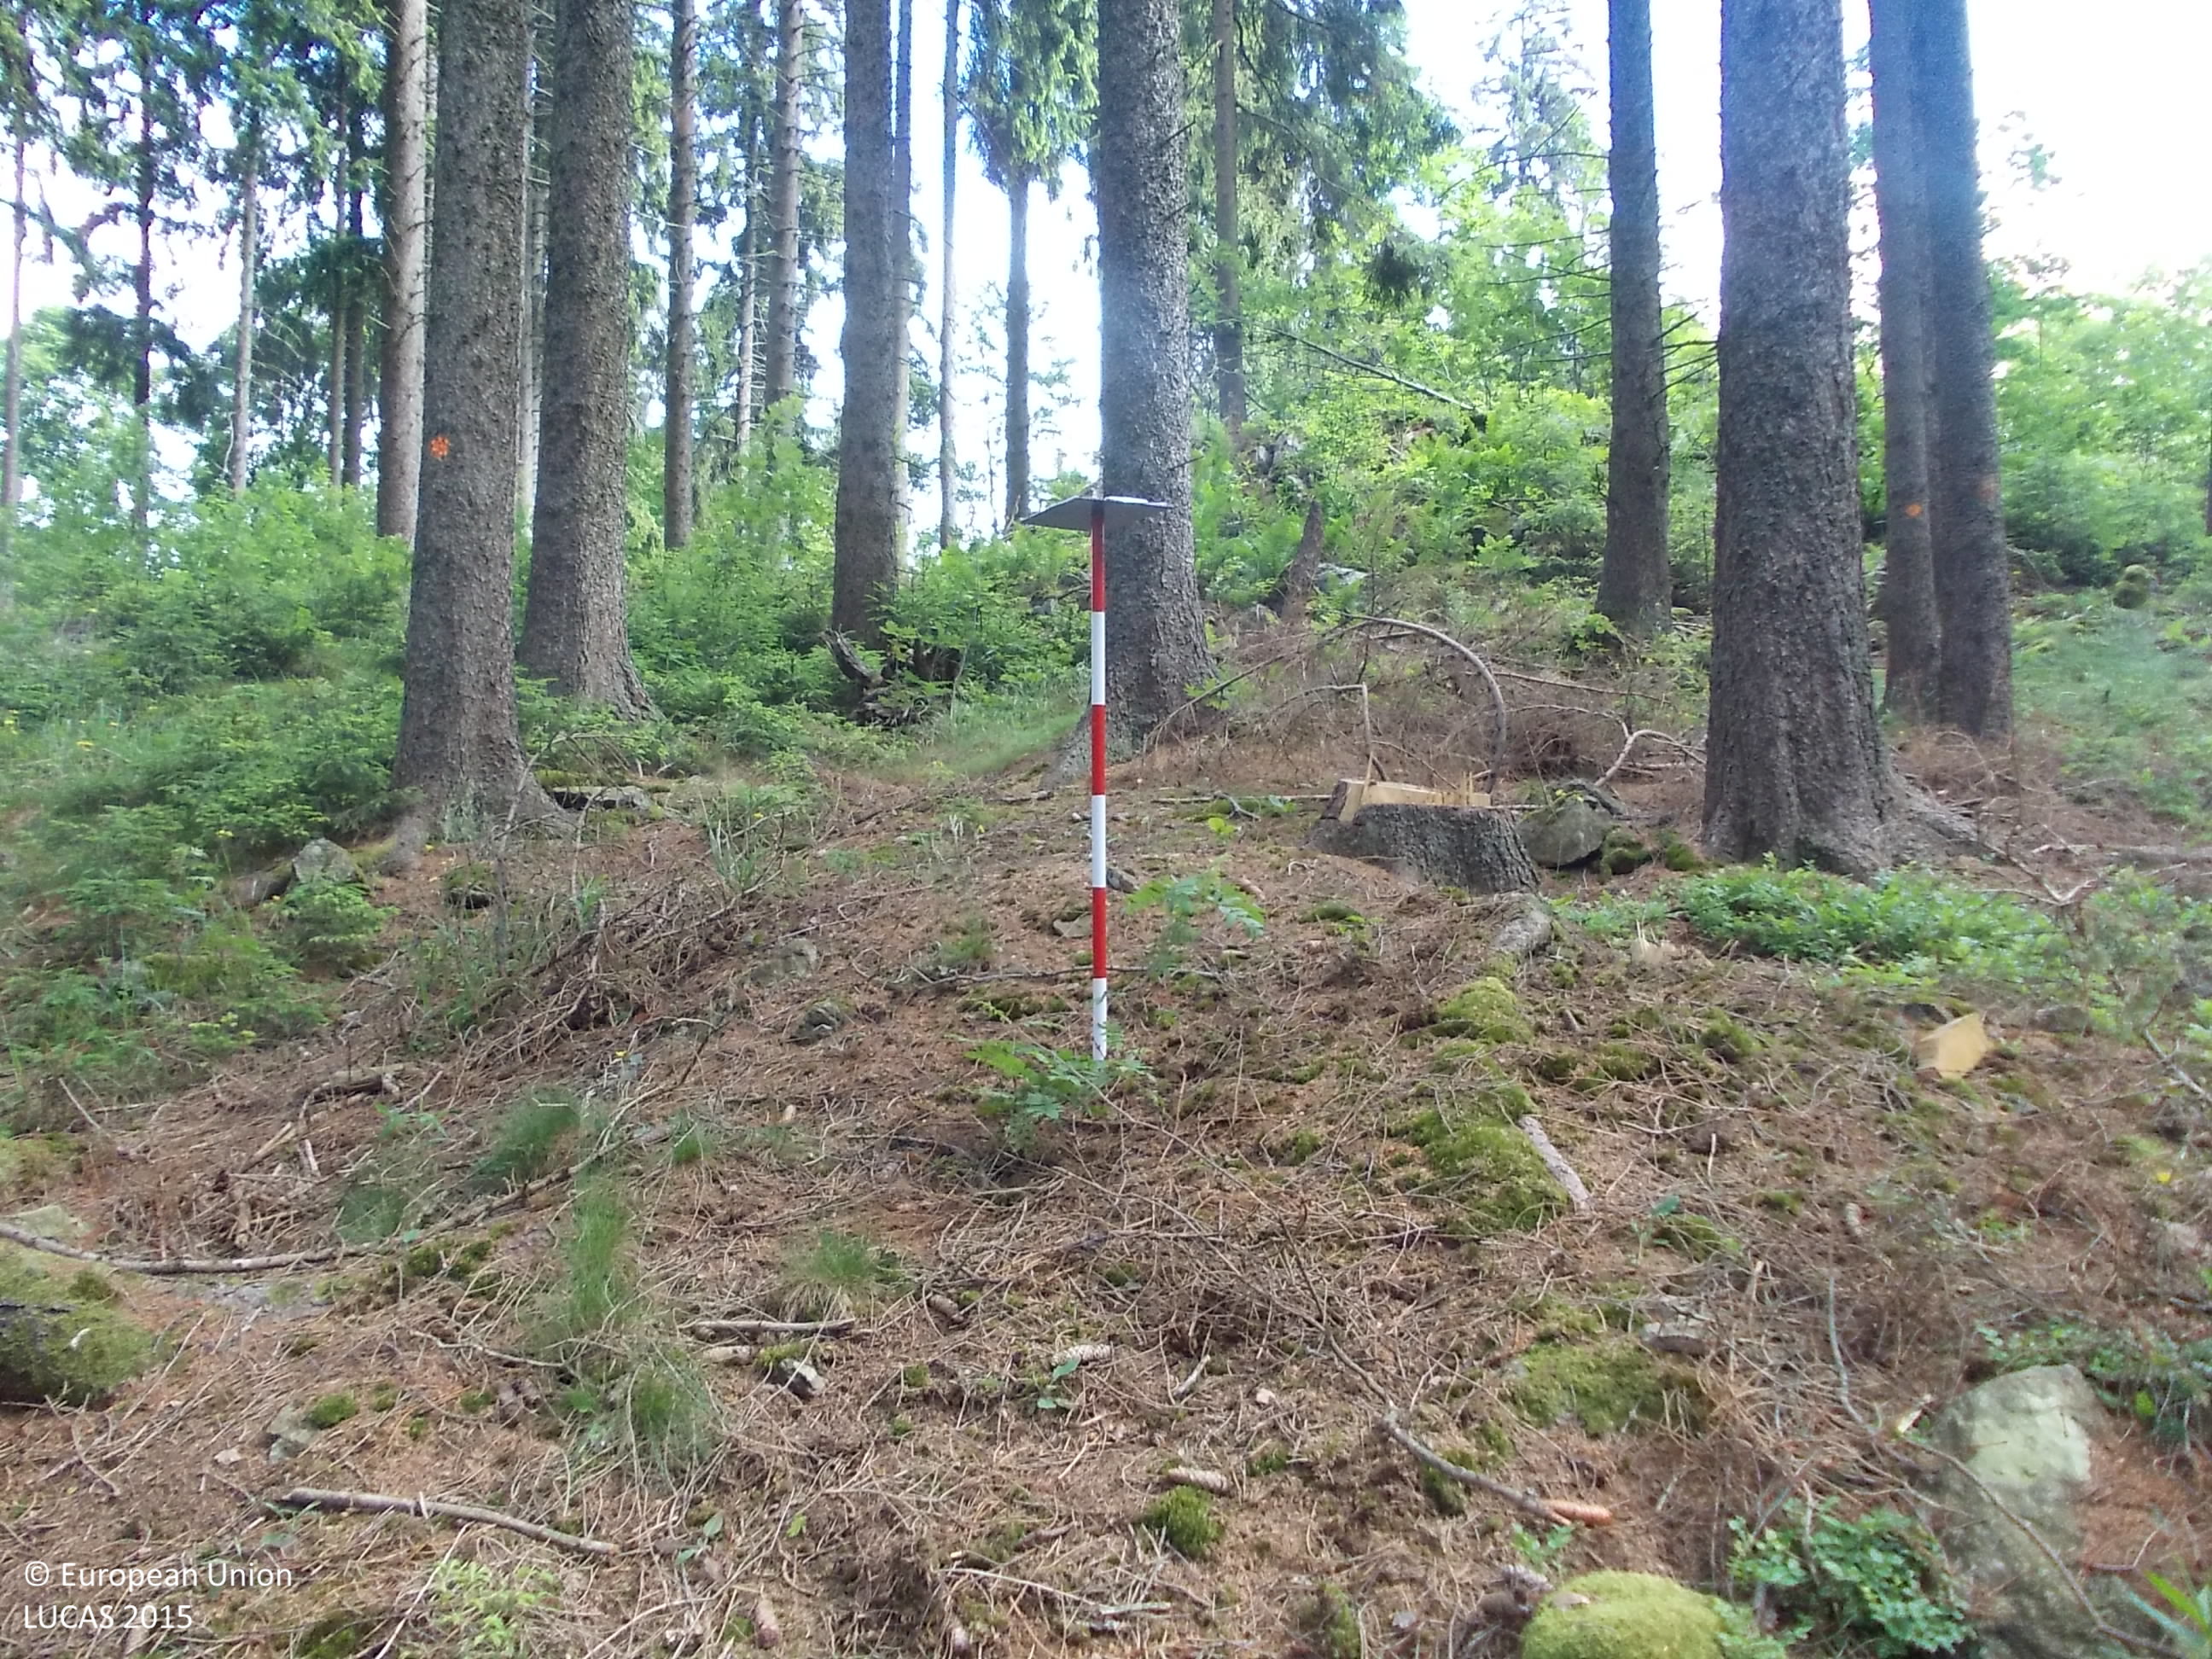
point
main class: Woodland
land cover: Spruce dominated coniferous woodland
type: hemiboreal forest and nemoral coniferous forest and mixed broadleaved-coniferous forest
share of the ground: > 75 %
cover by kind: coniferous forest trees 80 %, consolidated bare surface 10 %, herbaceous plants 5 %, lichens and mosses 5 %
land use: Forestry
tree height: > 5 m
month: June
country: CZ
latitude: 49.0437
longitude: 13.7076
